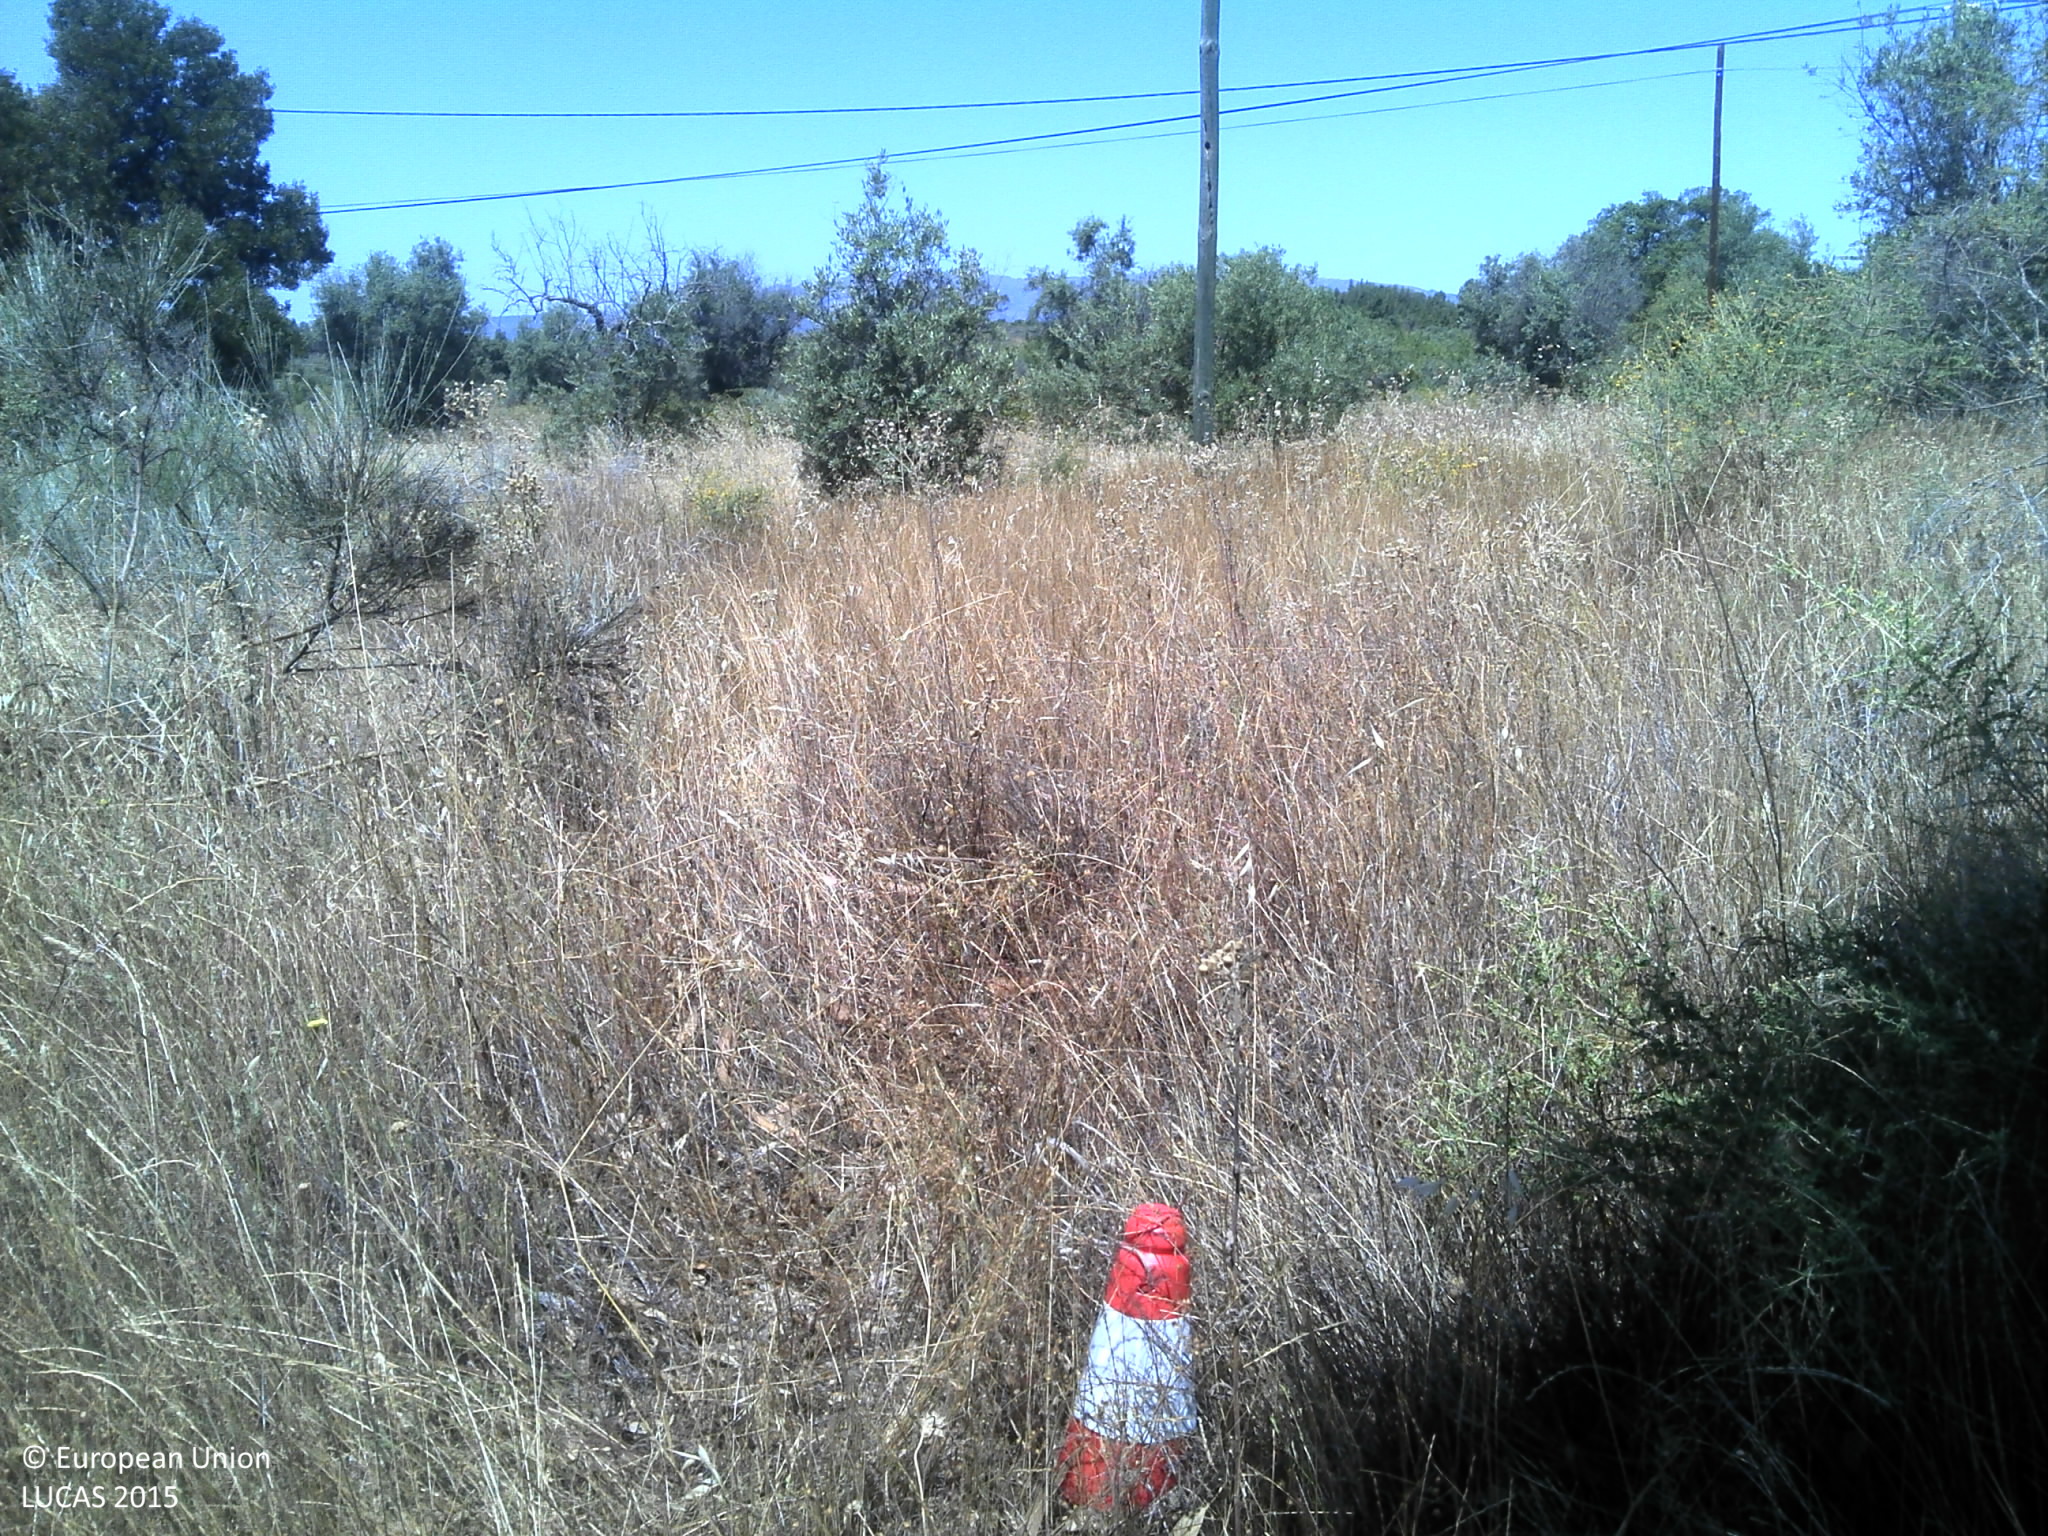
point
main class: Shrubland
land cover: Shrubland with sparse tree cover
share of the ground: 25 - 50 %
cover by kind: shrubs 40 %, herbaceous plants 40 %, unconsolidated bare surface 10 %, broadleaved forest trees 5 %
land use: Abandoned areas
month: June
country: PT
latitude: 40.0035
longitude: -7.3294
